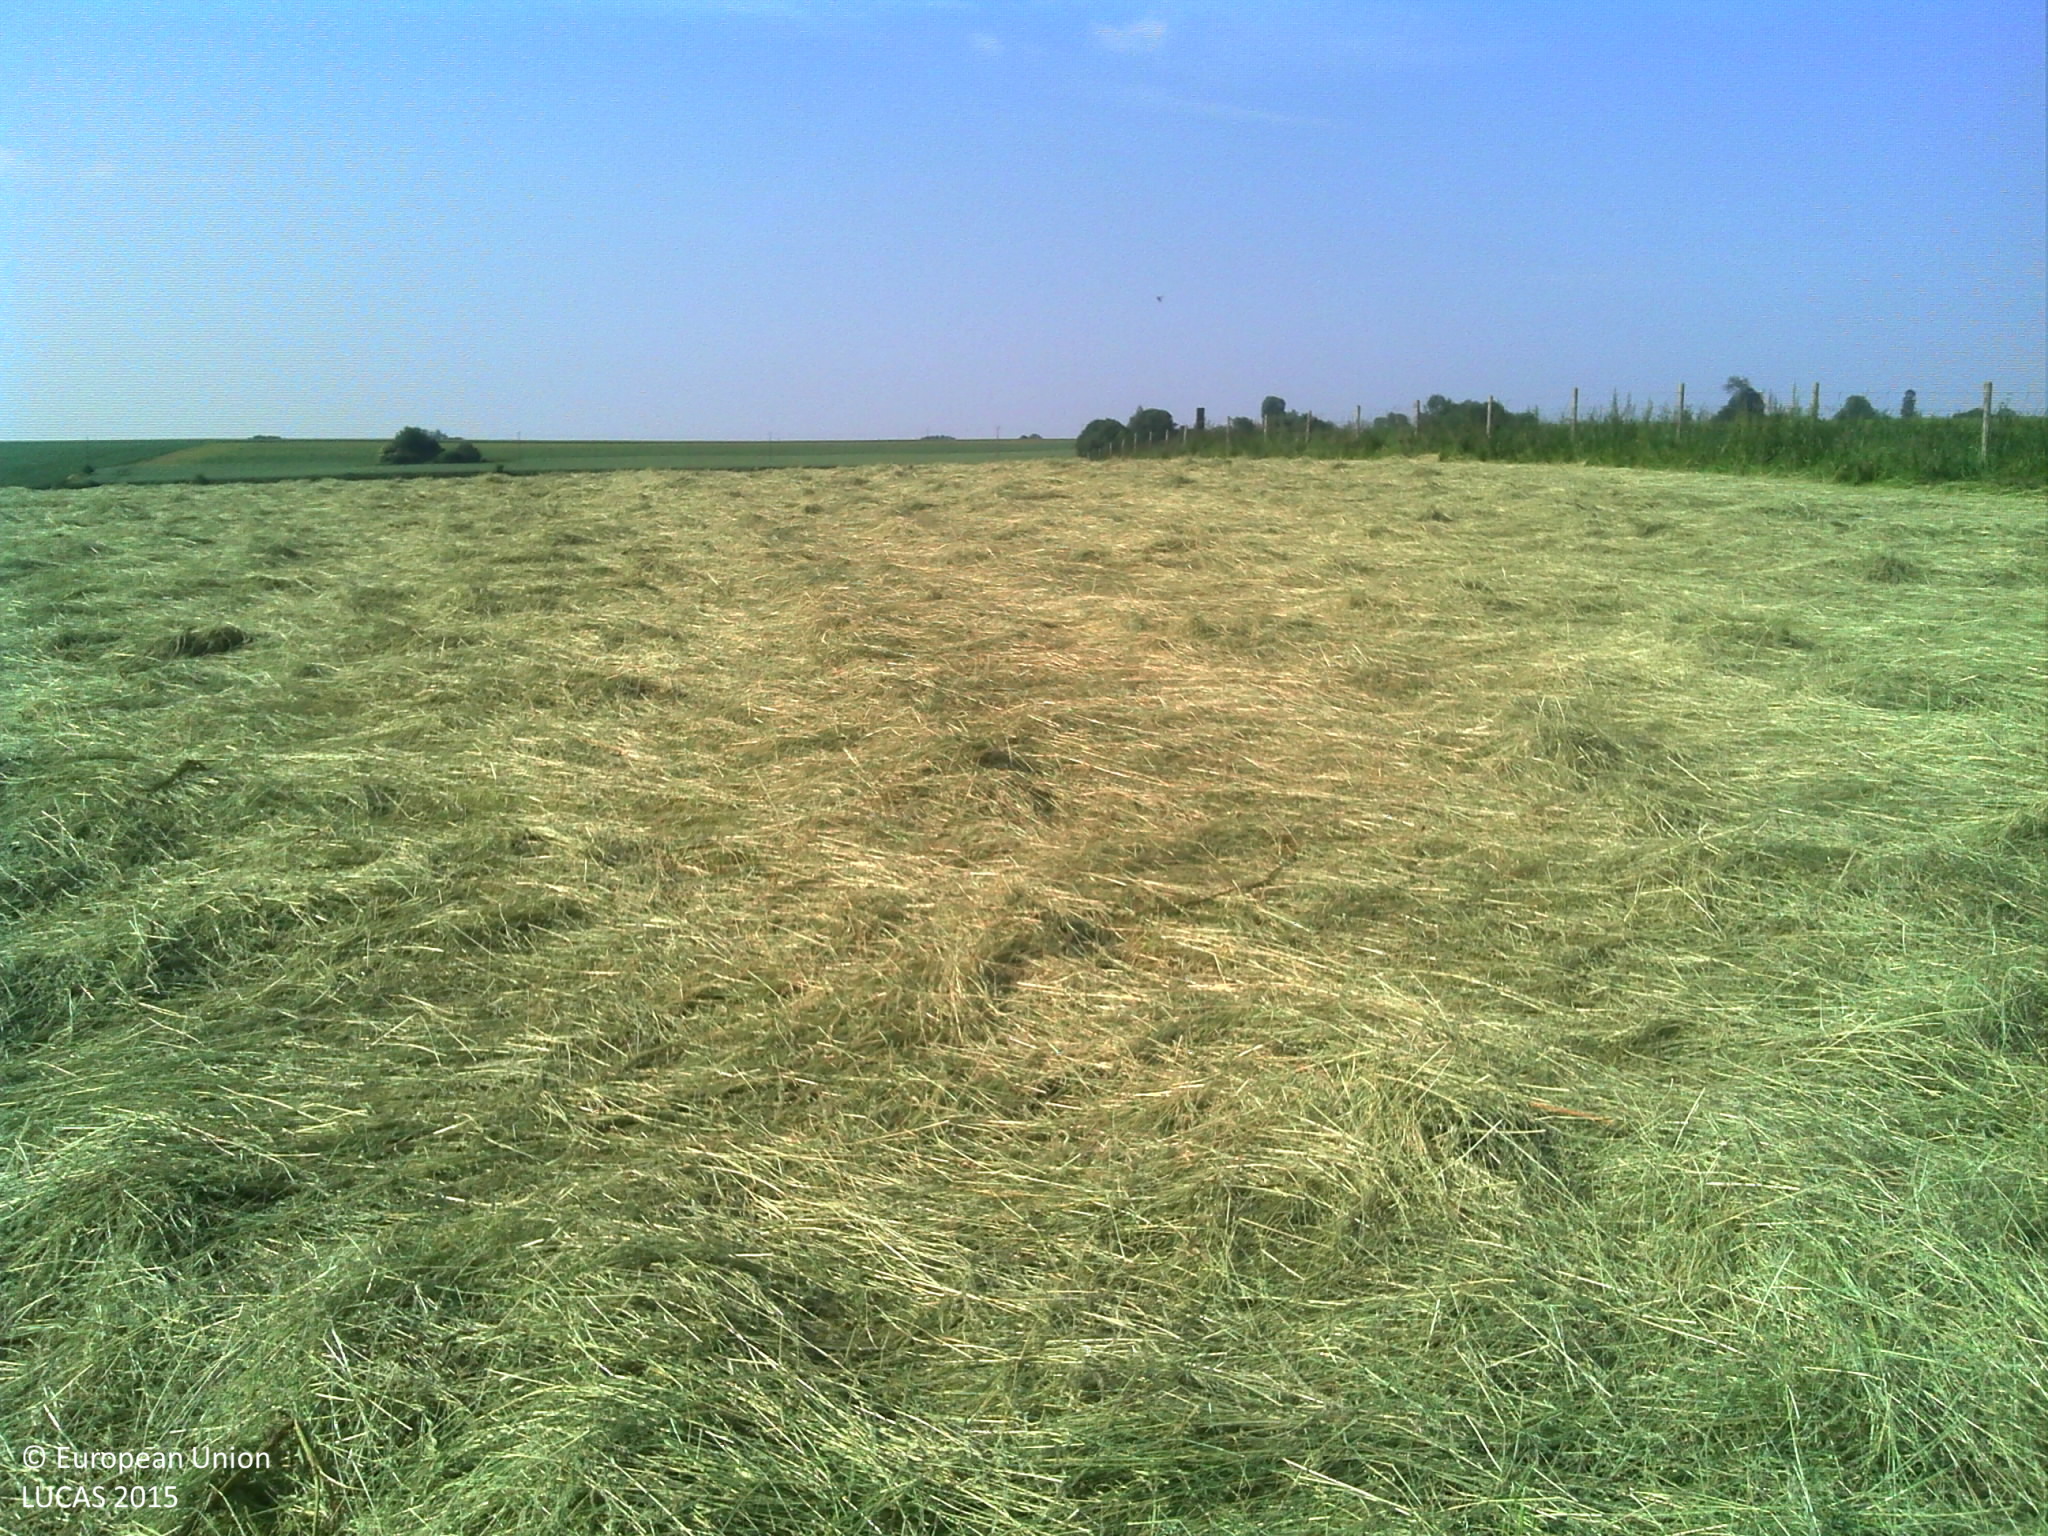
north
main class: Grassland
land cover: Grassland without tree/shrub cover
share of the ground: > 75 %
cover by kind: herbaceous plants 100 %
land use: Agriculture (excluding fallow land and kitchen gardens)
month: June
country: FR
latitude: 49.7787
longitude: 4.0928
